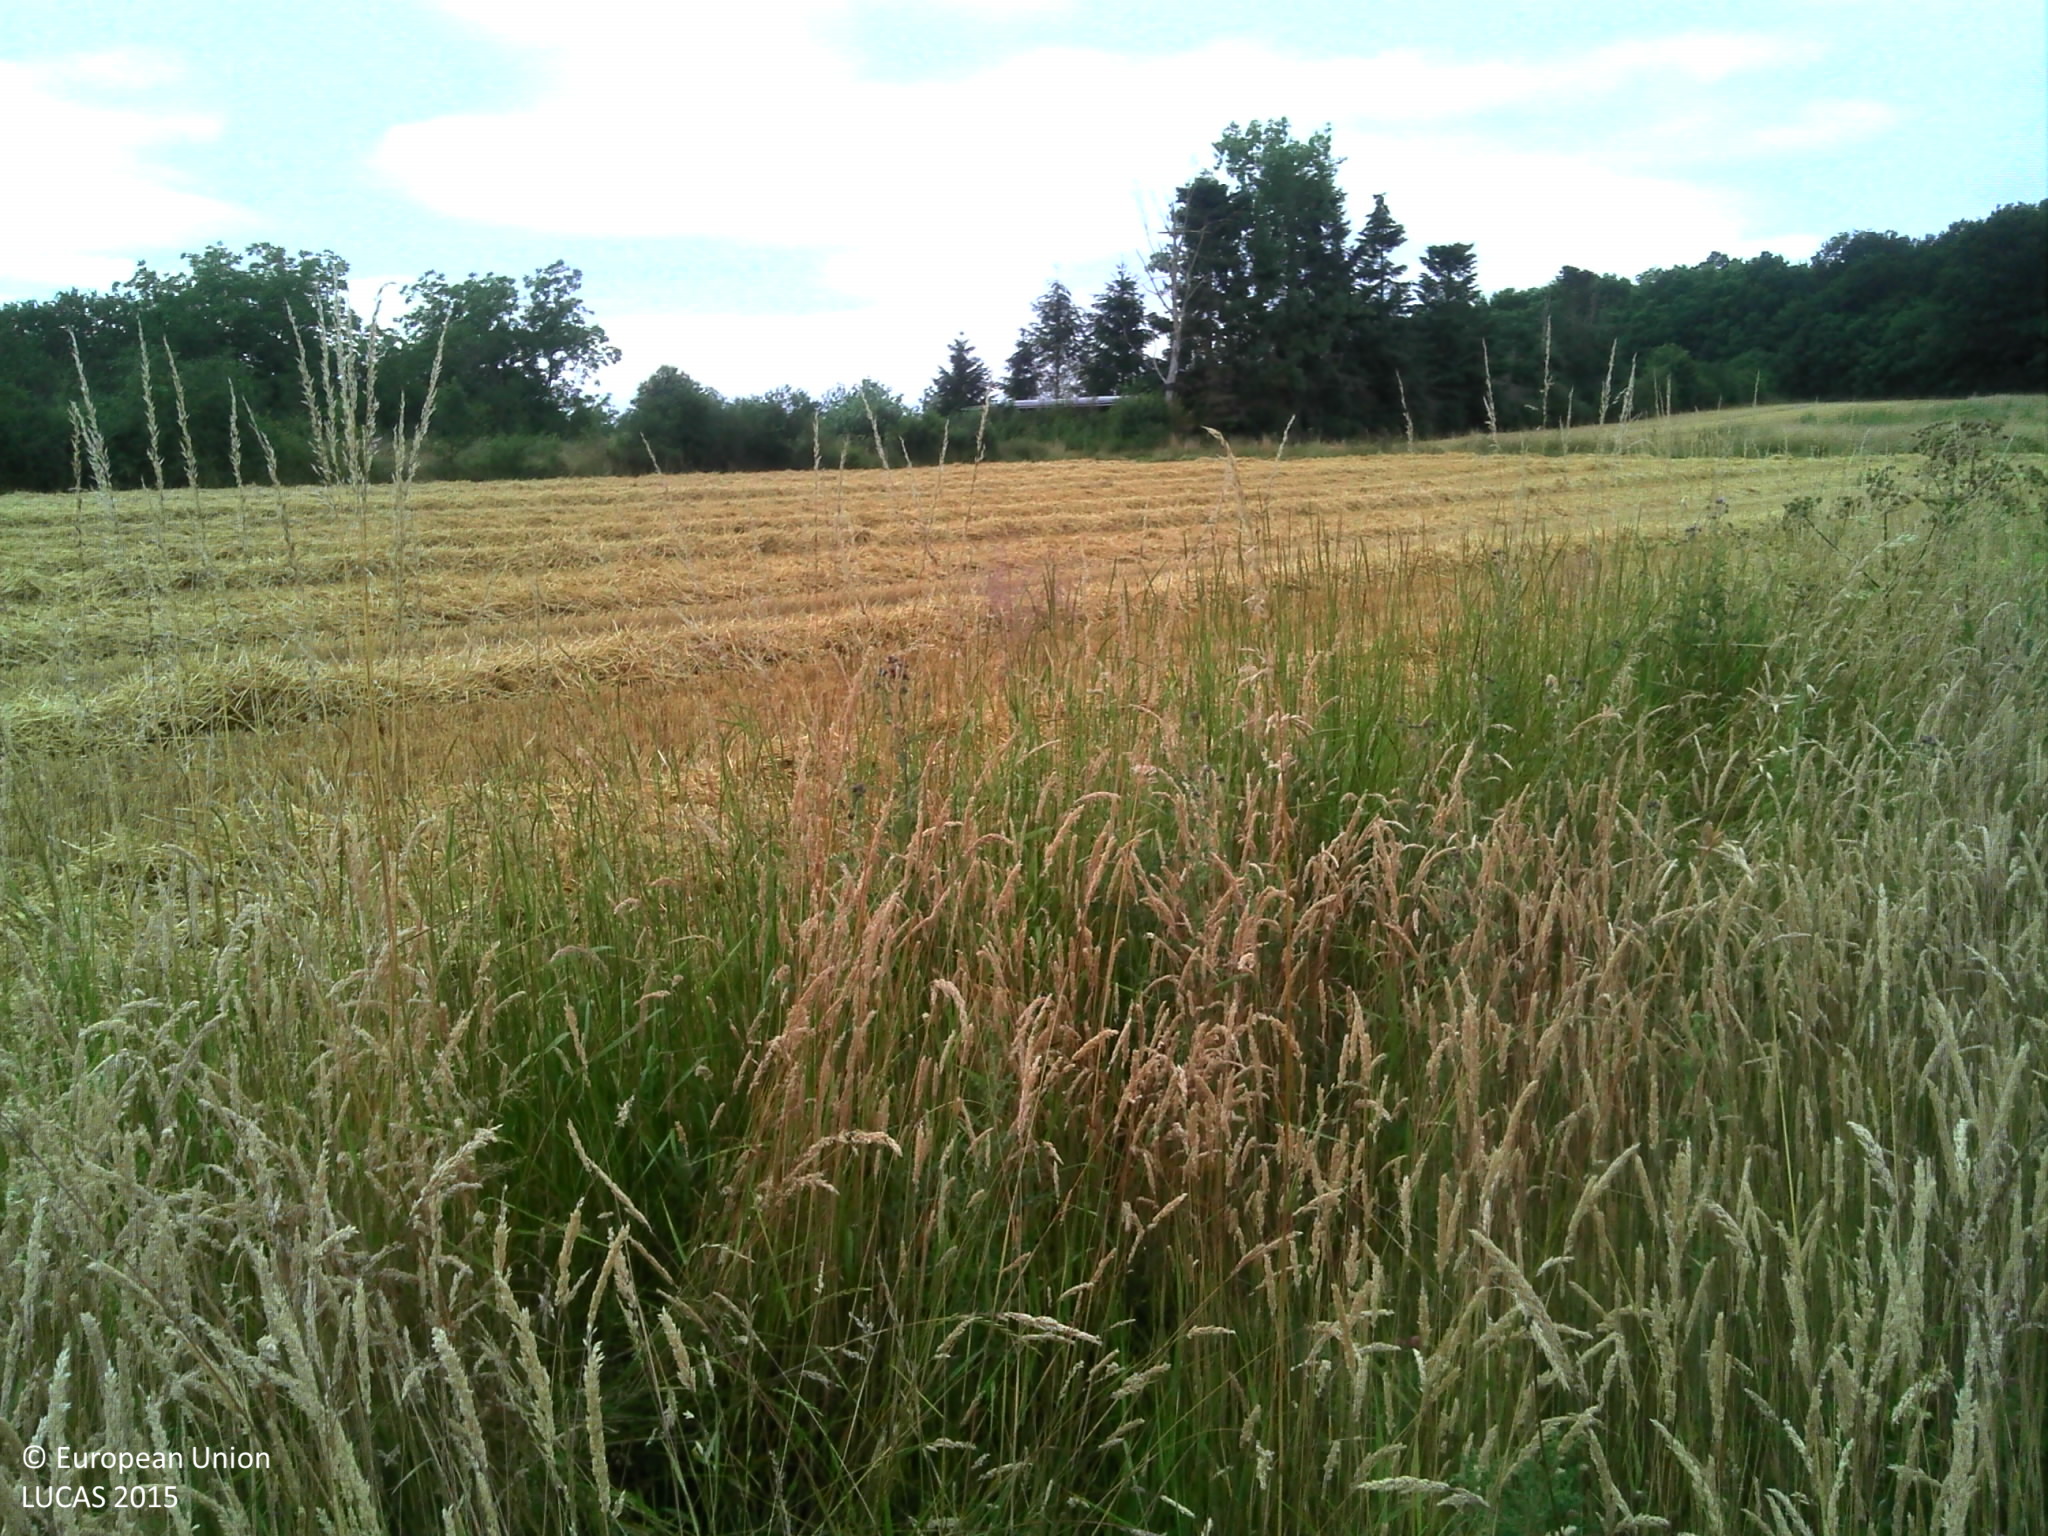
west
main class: Grassland
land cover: Grassland without tree/shrub cover
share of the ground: > 75 %
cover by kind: herbaceous plants 100 %
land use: Agriculture (excluding fallow land and kitchen gardens)
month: June
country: FR
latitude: 47.8356
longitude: 3.5425
